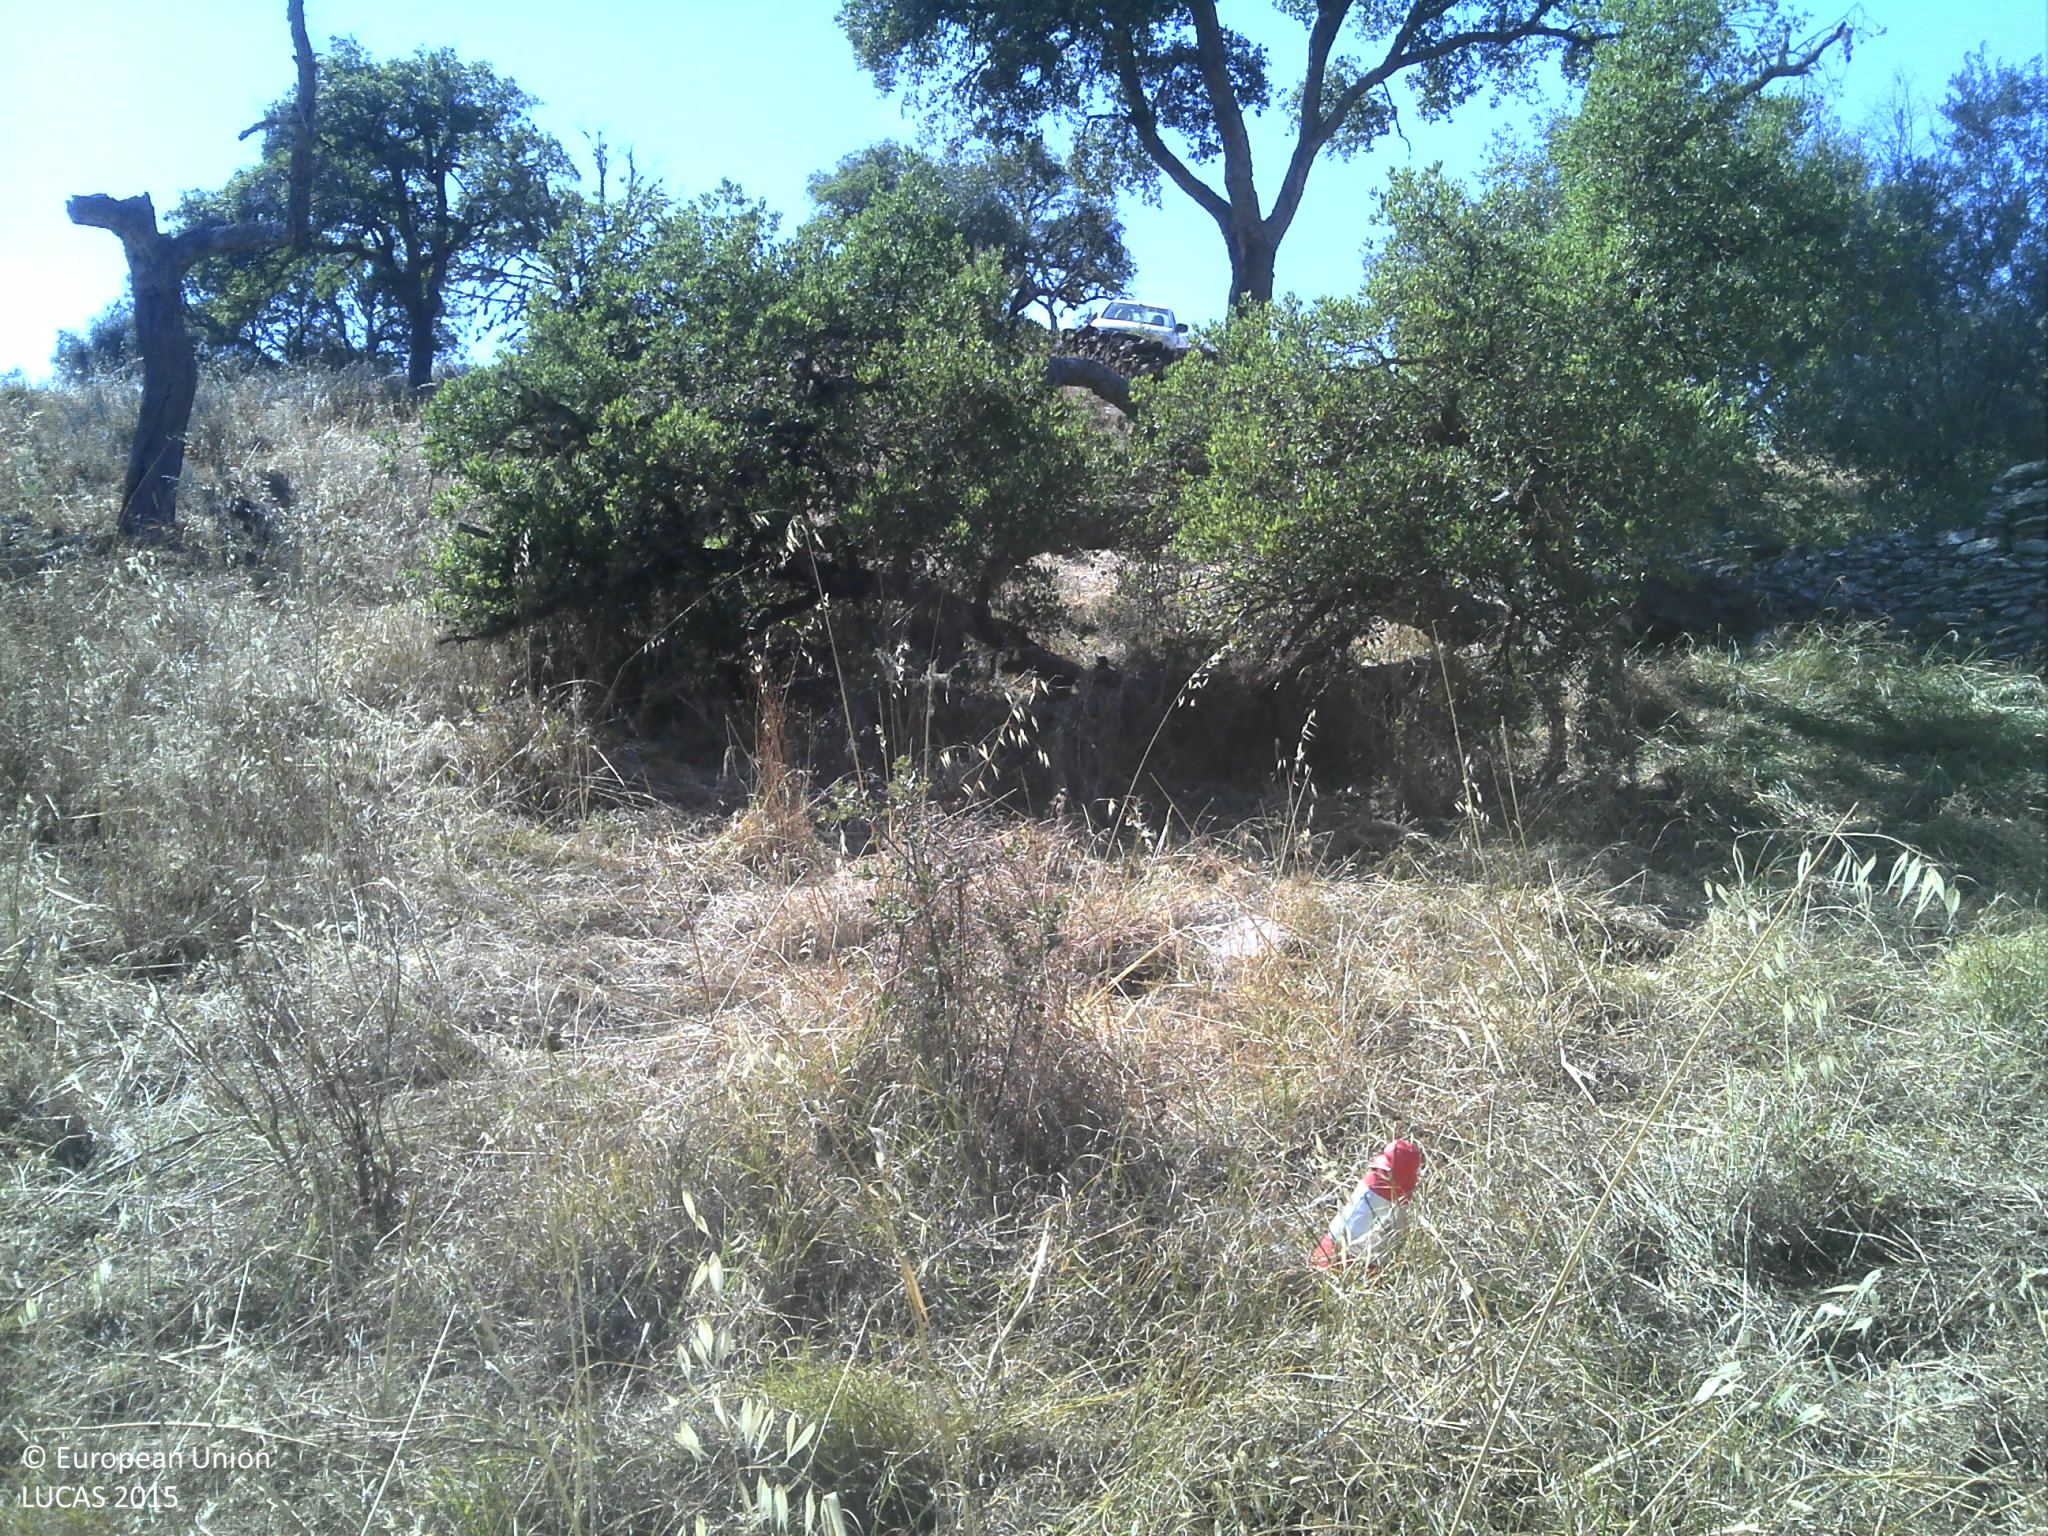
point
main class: Woodland
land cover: Broadleaved woodland
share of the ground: 25 - 50 %
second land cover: Spontaneously vegetated surfaces
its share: 25 - 50 %
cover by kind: herbaceous plants 40 %, broadleaved forest trees 35 %, unconsolidated bare surface 20 %, shrubs 5 %
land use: Forestry
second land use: Agriculture (excluding fallow land and kitchen gardens)
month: July
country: PT
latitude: 39.6645
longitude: -7.5711
